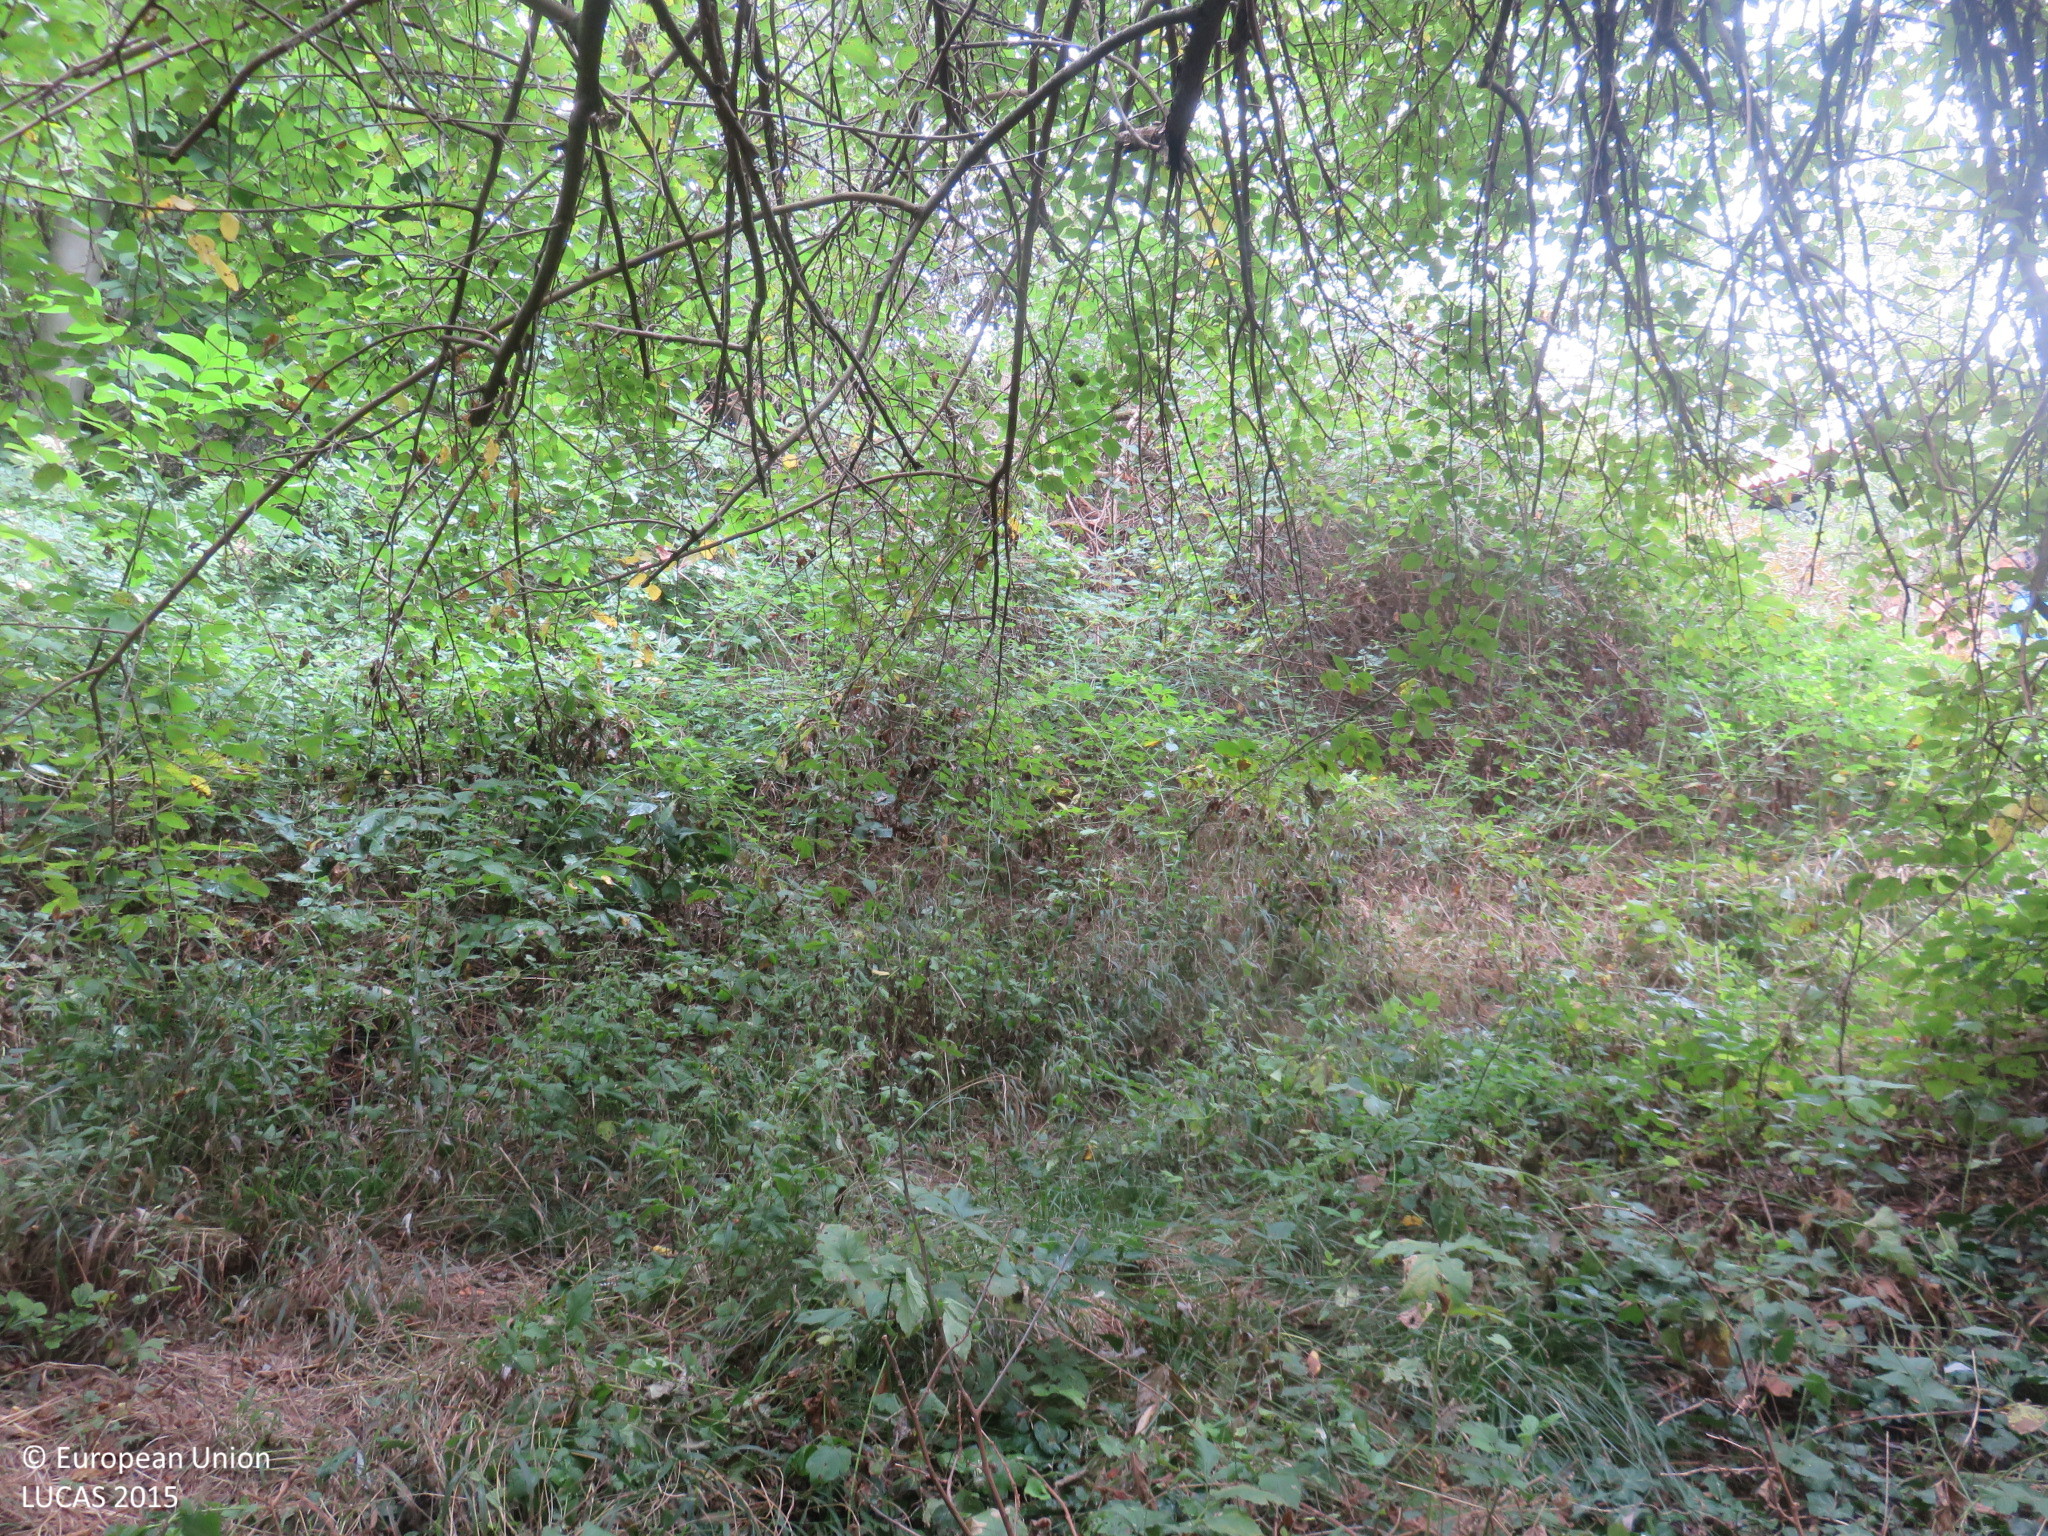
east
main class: Woodland
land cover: Broadleaved woodland
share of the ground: > 75 %
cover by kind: broadleaved forest trees 80 %, shrubs 10 %, herbaceous plants 10 %
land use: Residential
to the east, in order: Broadleaved woodland; Artificial constructions in urban areas; Broadleaved woodland; Artificial constructions in urban areas; Broadleaved woodland
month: September
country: BG
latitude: 43.0999
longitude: 24.7947
